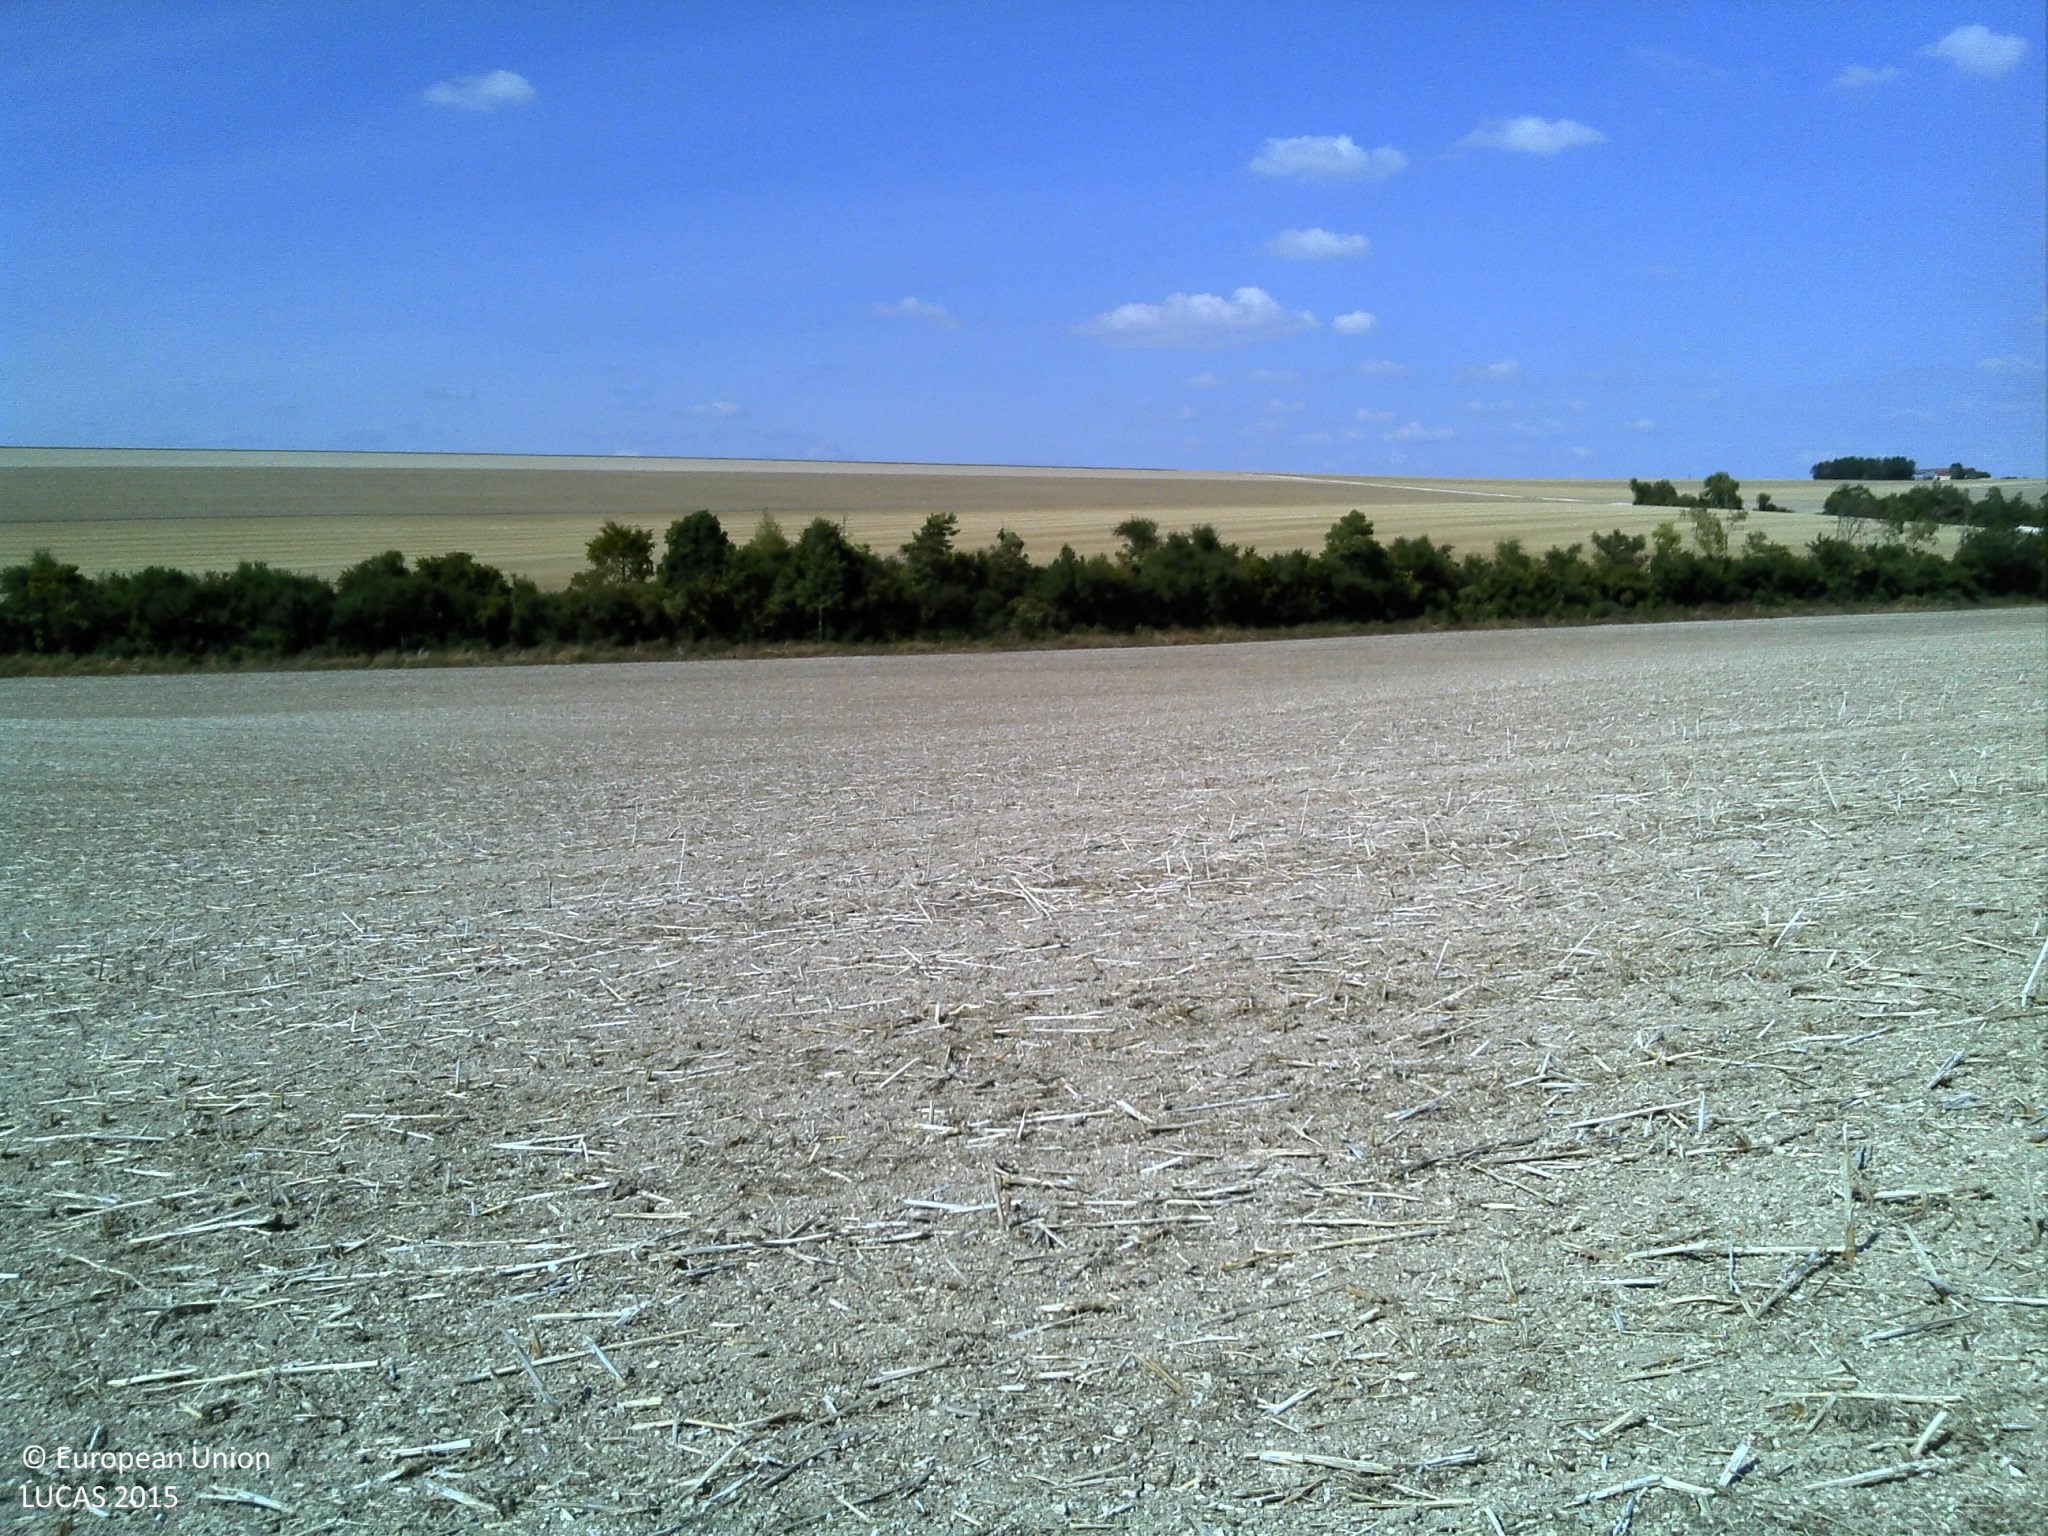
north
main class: Cropland
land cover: Rape and turnip rape
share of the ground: > 75 %
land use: Agriculture (excluding fallow land and kitchen gardens)
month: August
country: FR
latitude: 48.9429
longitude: 4.6861
